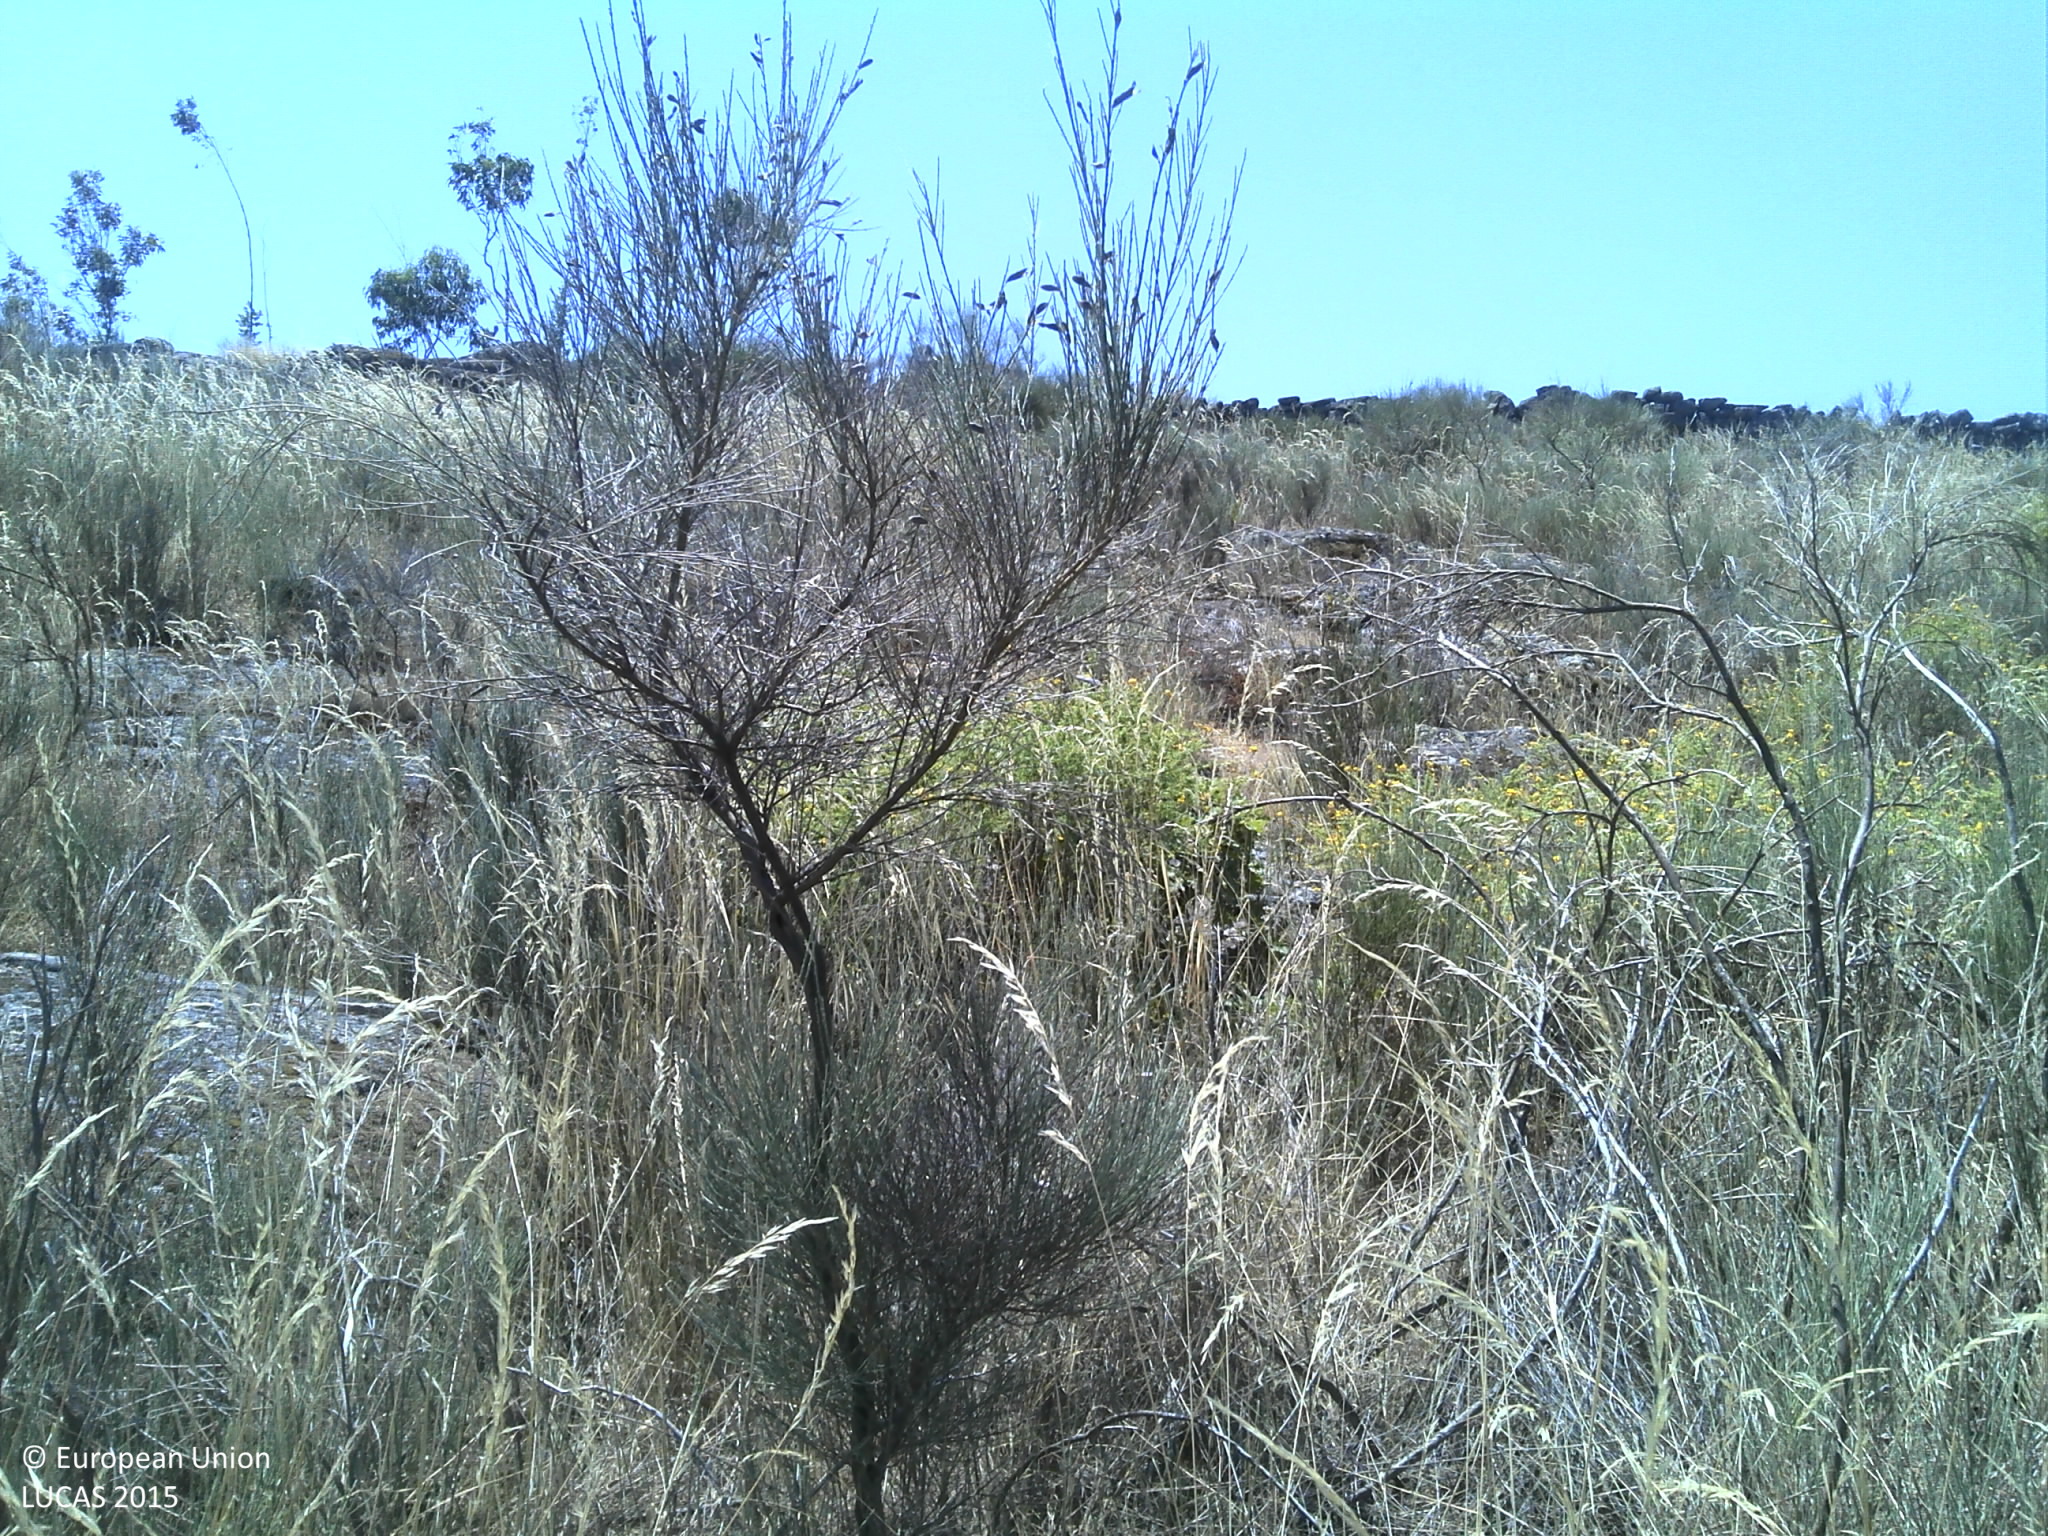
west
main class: Shrubland
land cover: Shrubland with sparse tree cover
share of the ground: 50 - 75 %
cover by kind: shrubs 60 %, herbaceous plants 25 %, broadleaved forest trees 5 %, unconsolidated bare surface 5 %
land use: Forestry
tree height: > 5 m
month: June
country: PT
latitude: 40.0620
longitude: -7.1053
